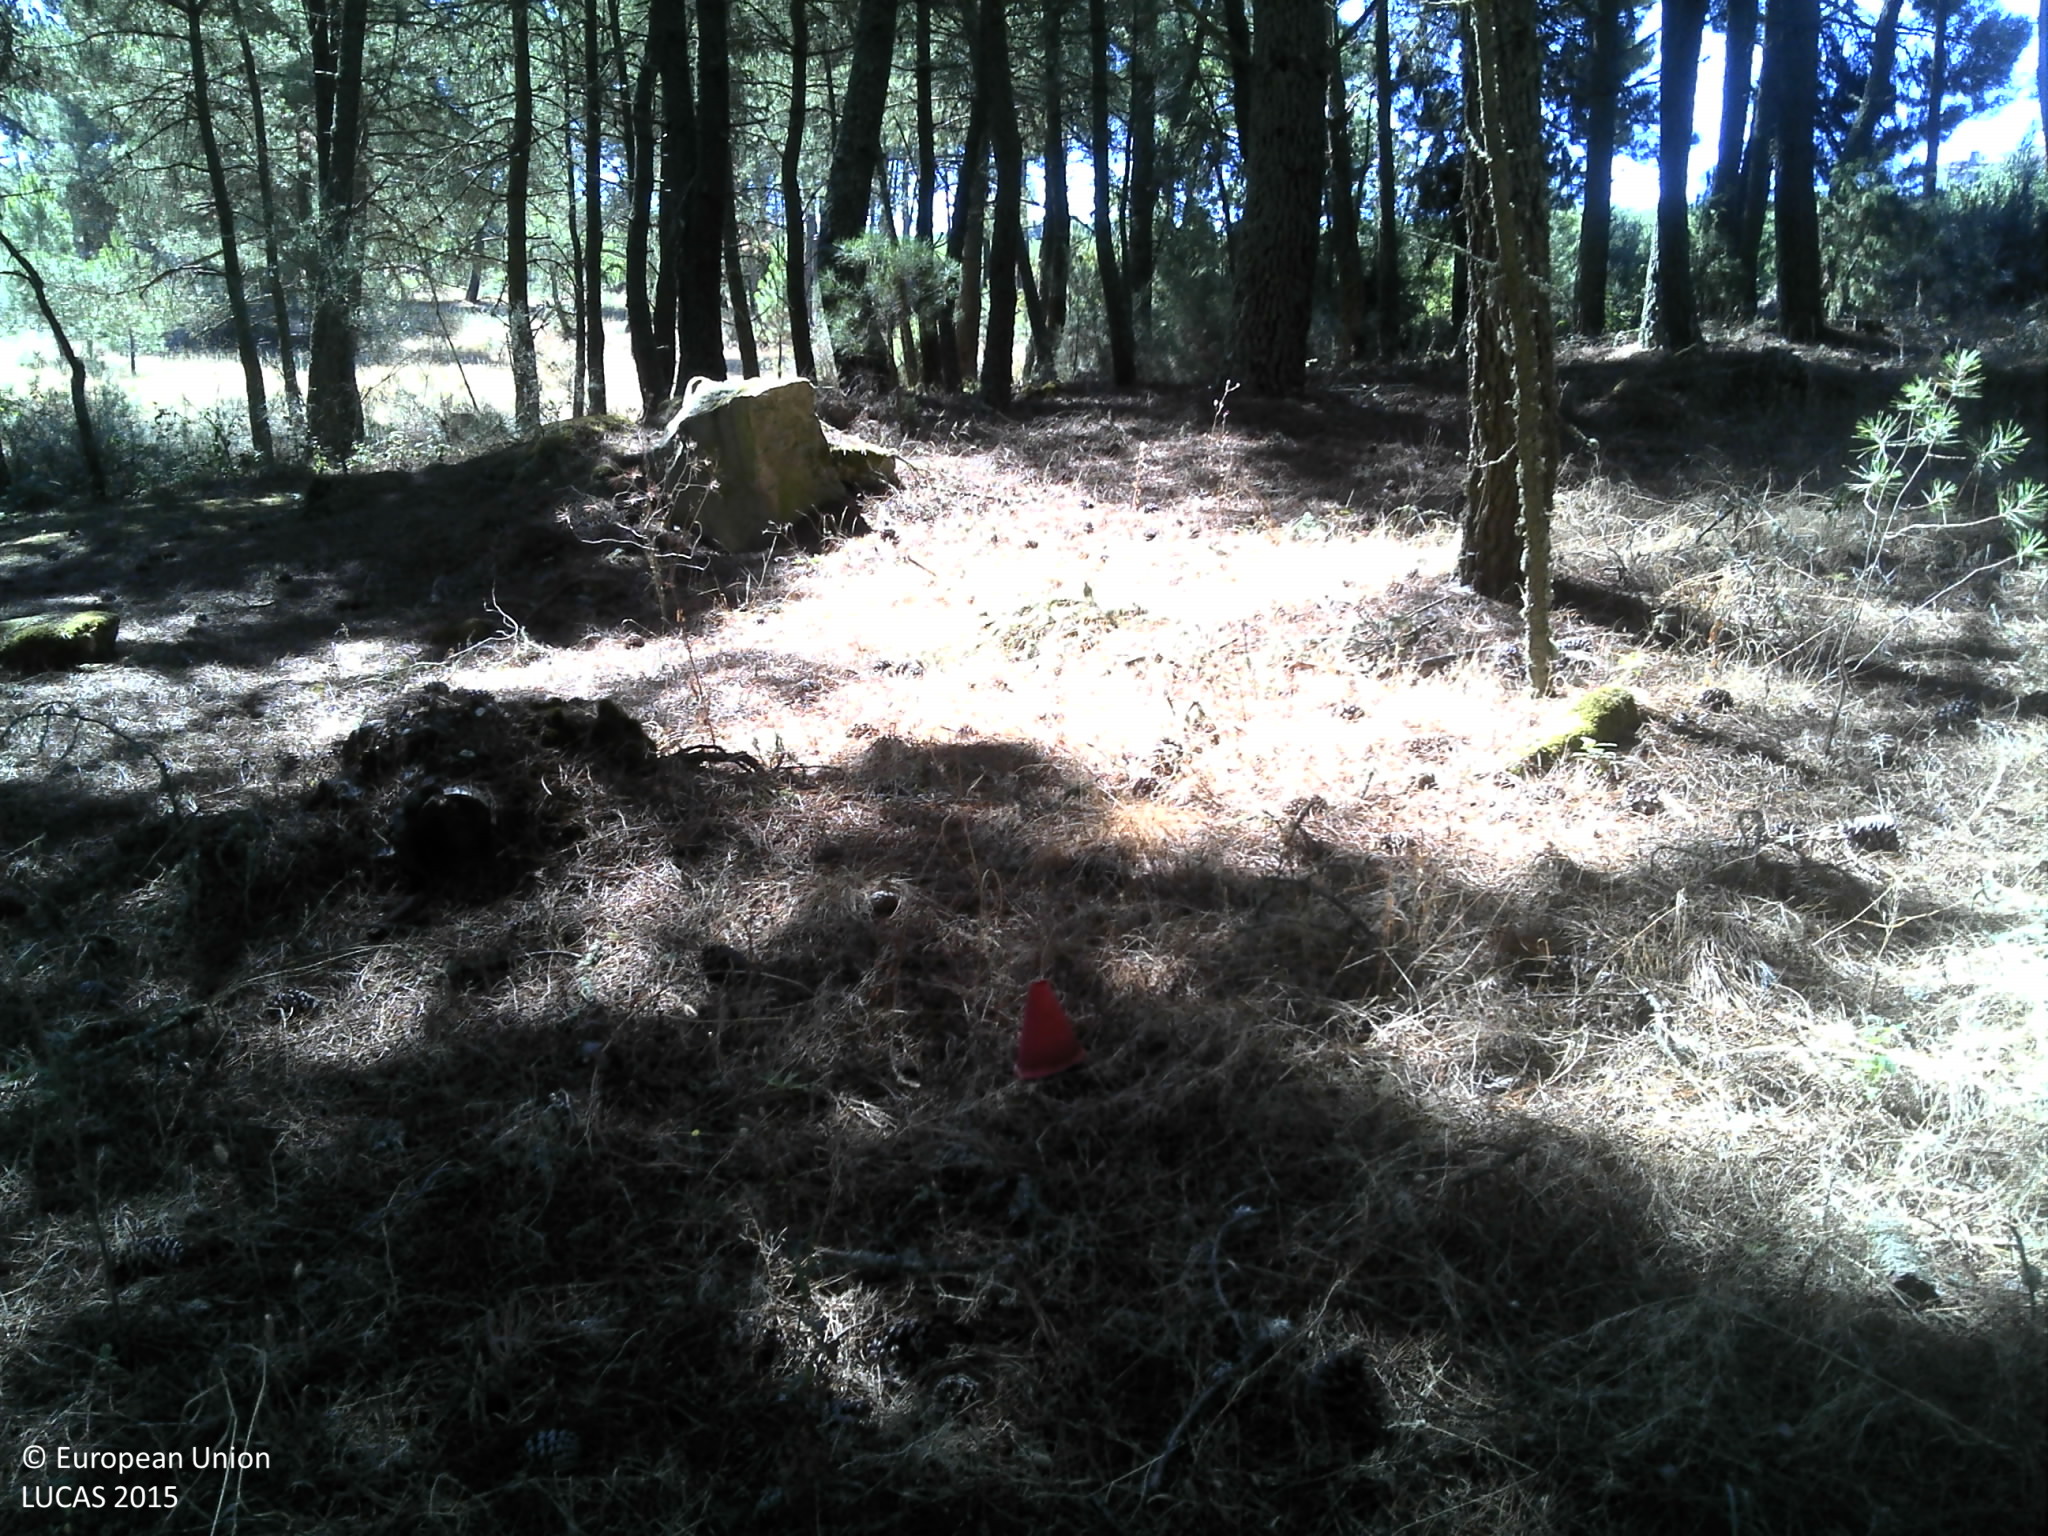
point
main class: Woodland
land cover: Pine dominated coniferous woodland
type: coniferous forest of the mediterranean region
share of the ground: < 10 %
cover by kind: unconsolidated bare surface 75 %, coniferous forest trees 20 %, shrubs 5 %
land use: Forestry
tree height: > 5 m
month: July
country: PT
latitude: 41.2285
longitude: -7.2844
